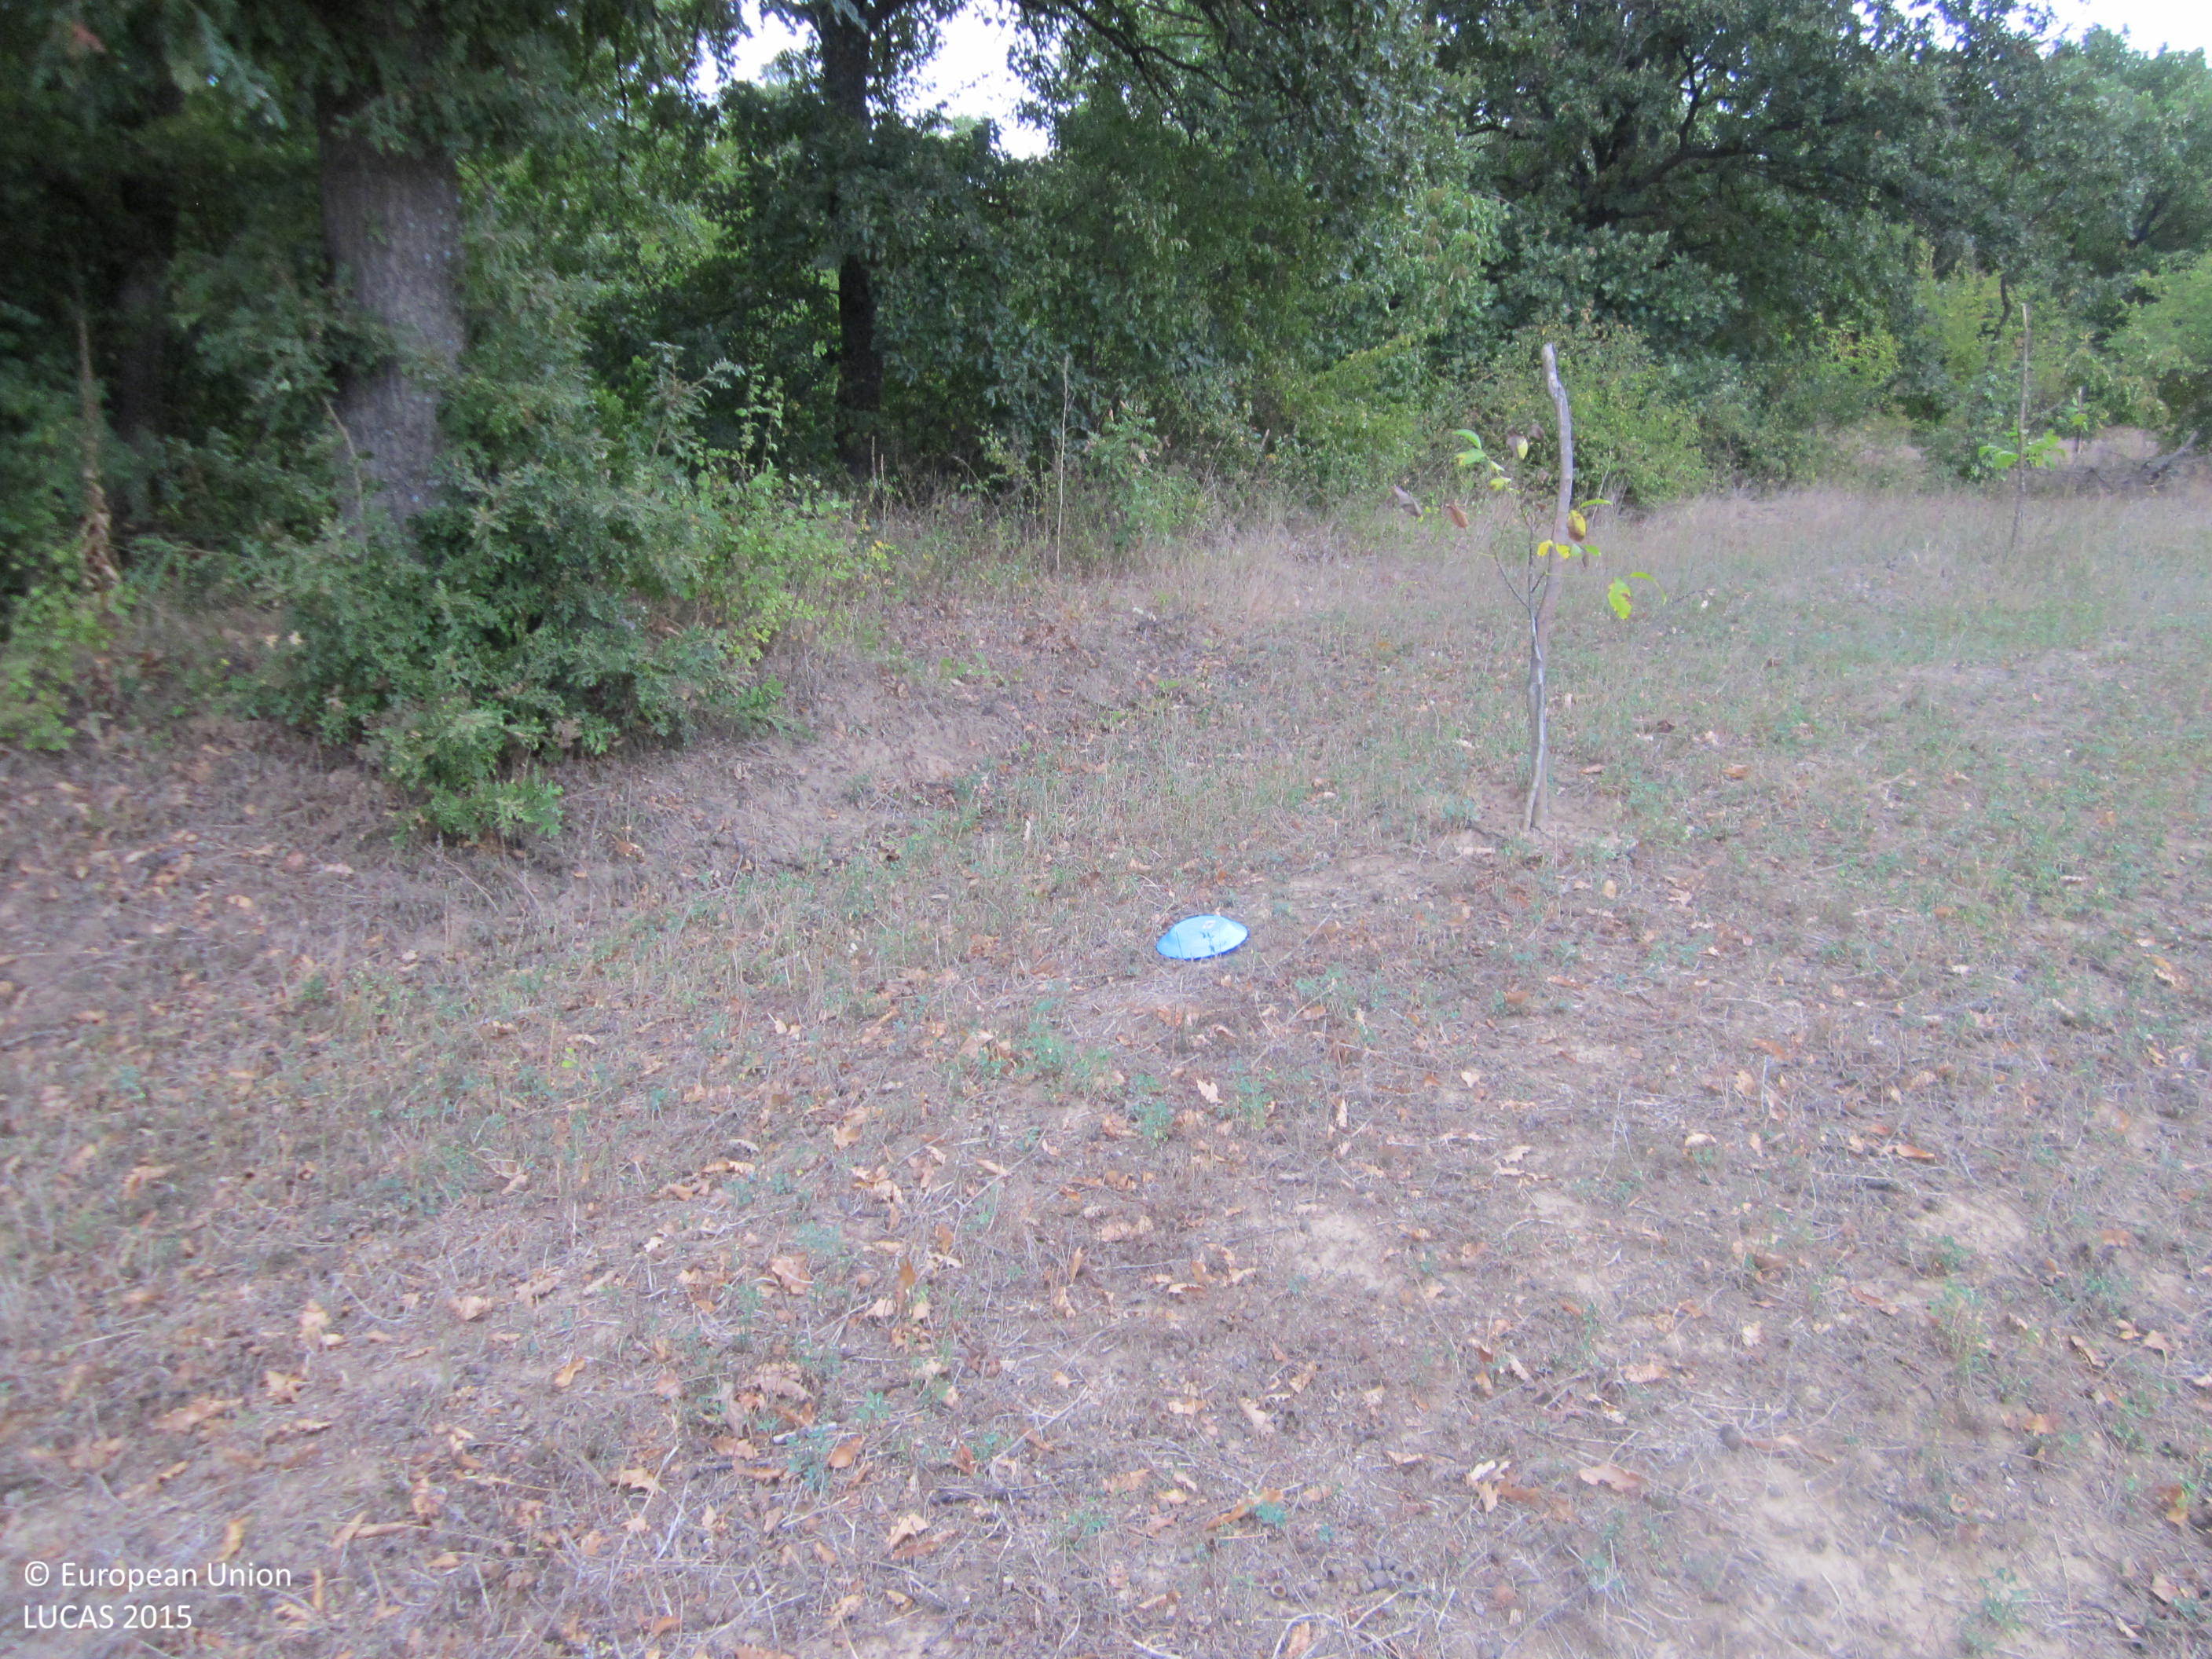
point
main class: Cropland
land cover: Nuts trees
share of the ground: 10 - 25 %
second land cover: Grassland without tree/shrub cover
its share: 25 - 50 %
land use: Agriculture (excluding fallow land and kitchen gardens)
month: September
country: BG
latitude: 42.8114
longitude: 27.3995
